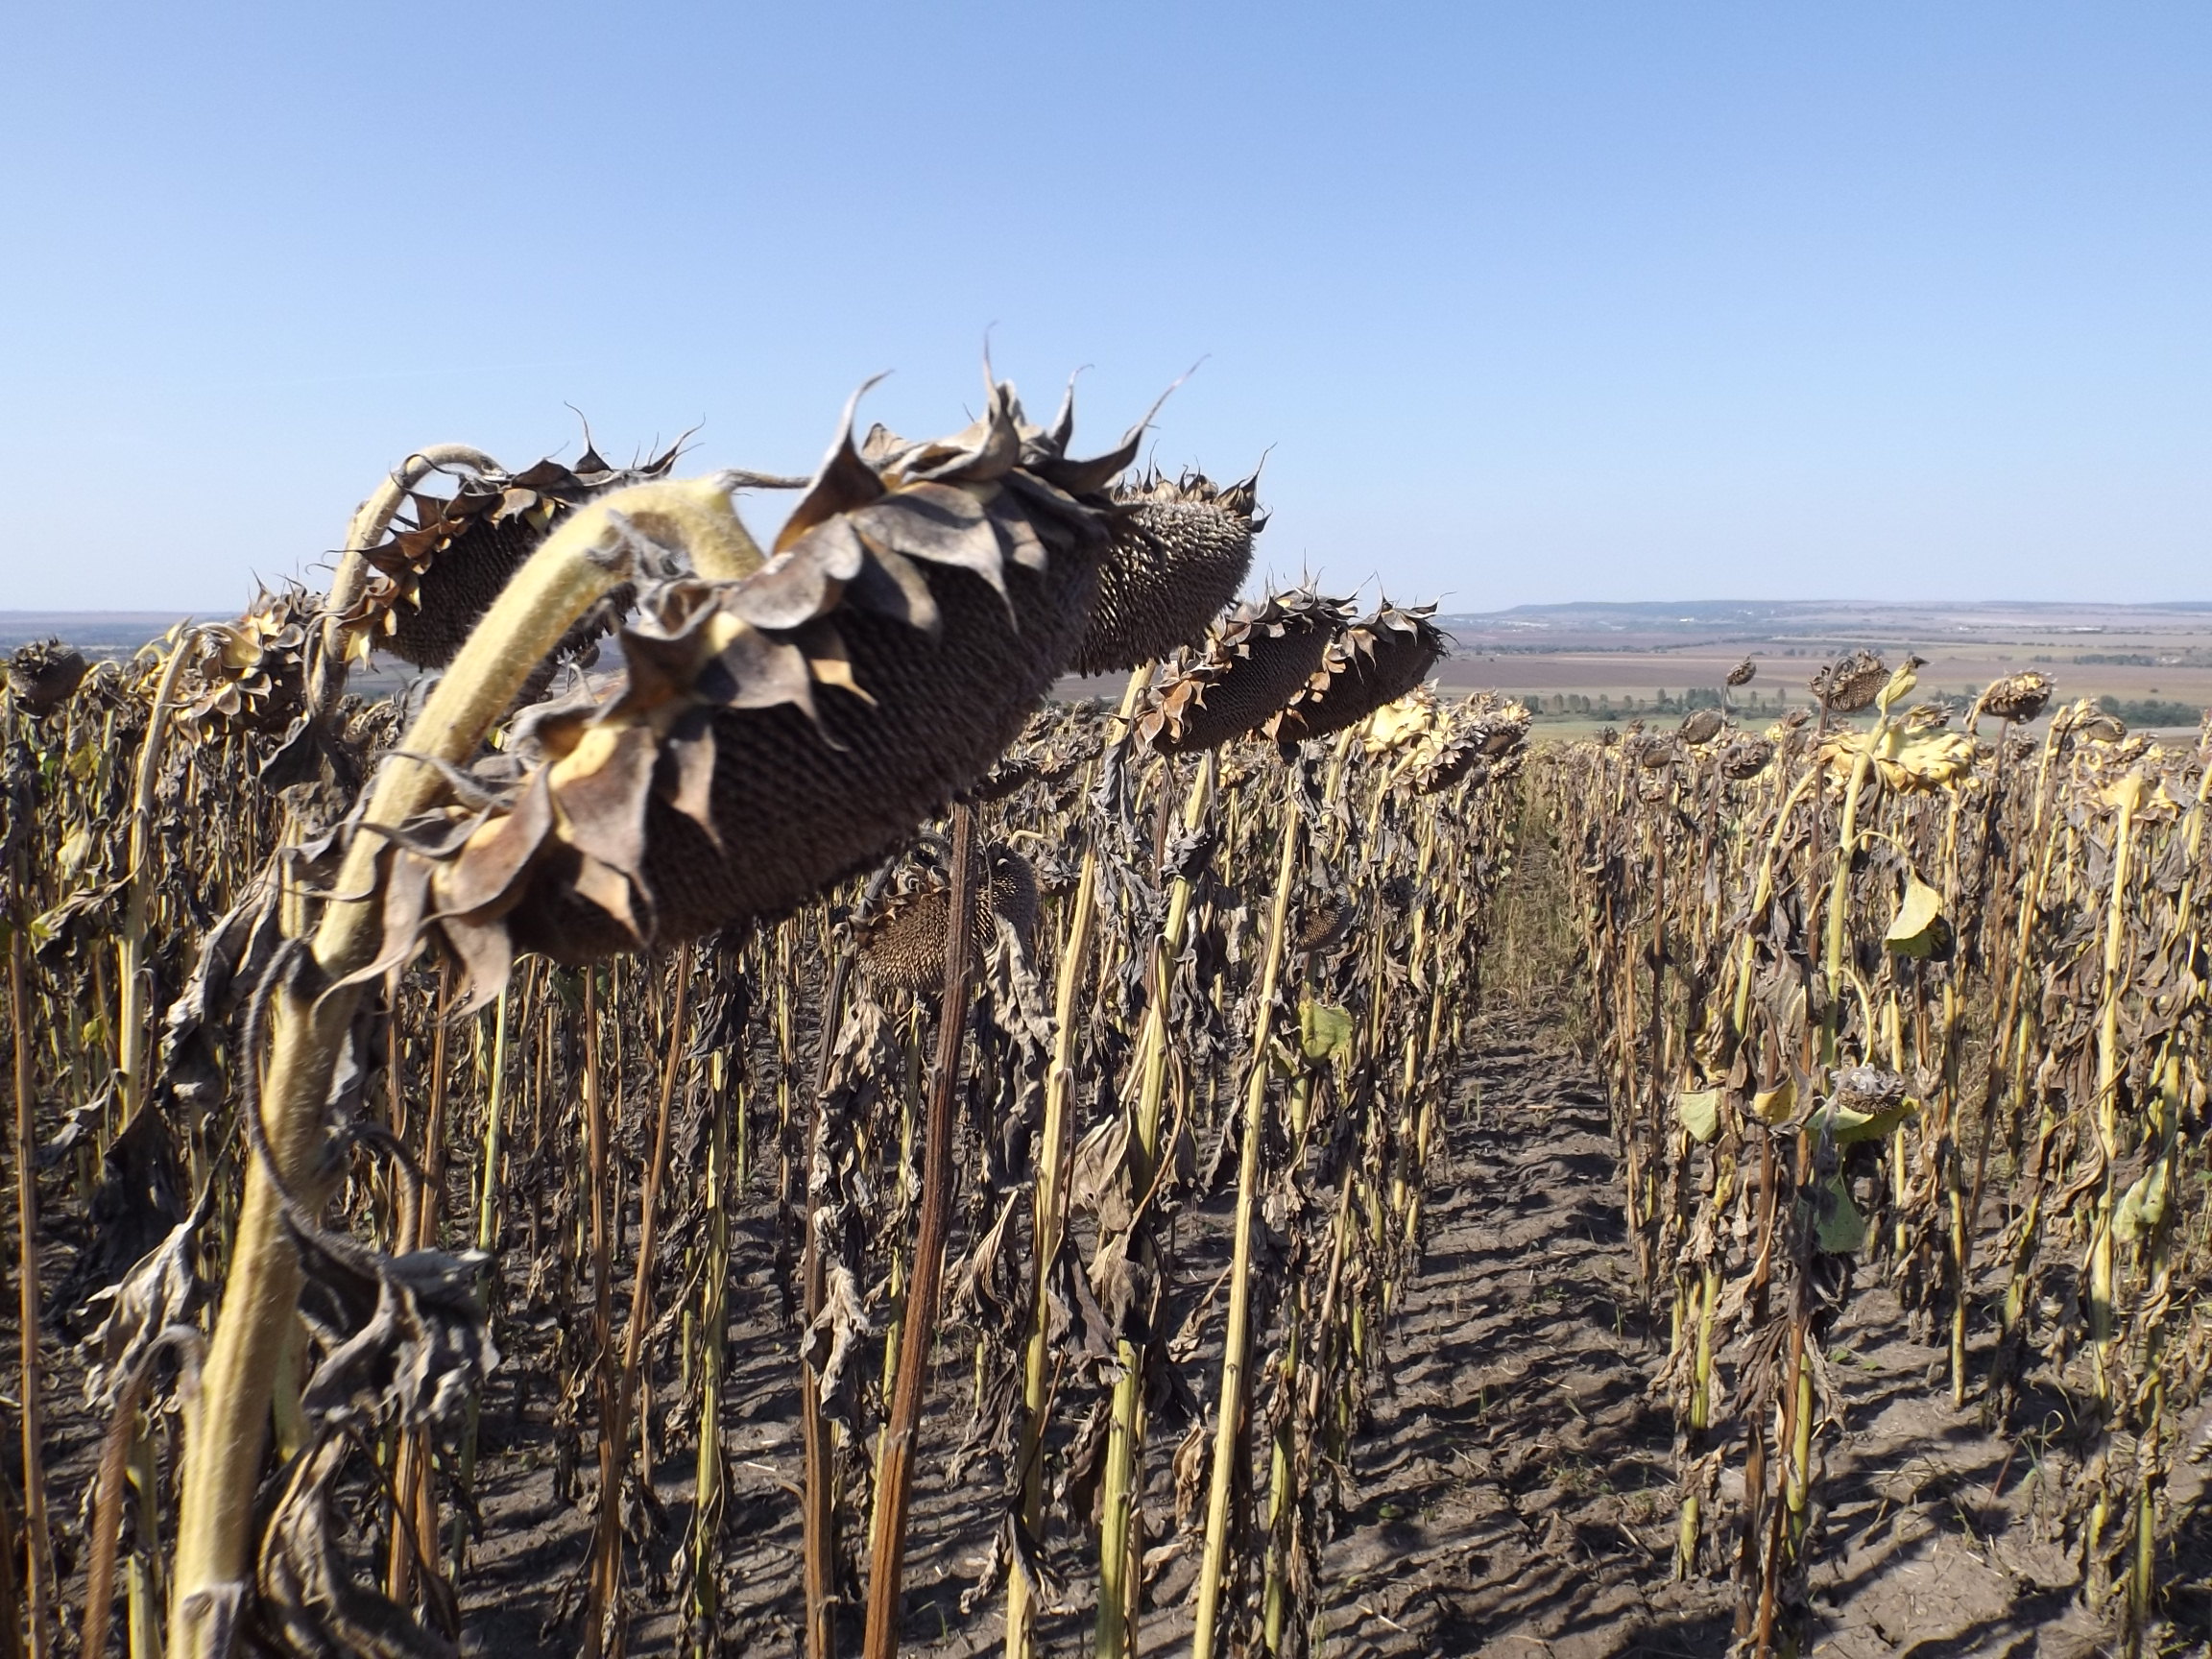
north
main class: Cropland
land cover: Sunflower
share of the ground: > 75 %
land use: Agriculture (excluding fallow land and kitchen gardens)
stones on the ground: < 10 %
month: August
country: BG
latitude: 43.1040
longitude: 27.4120
